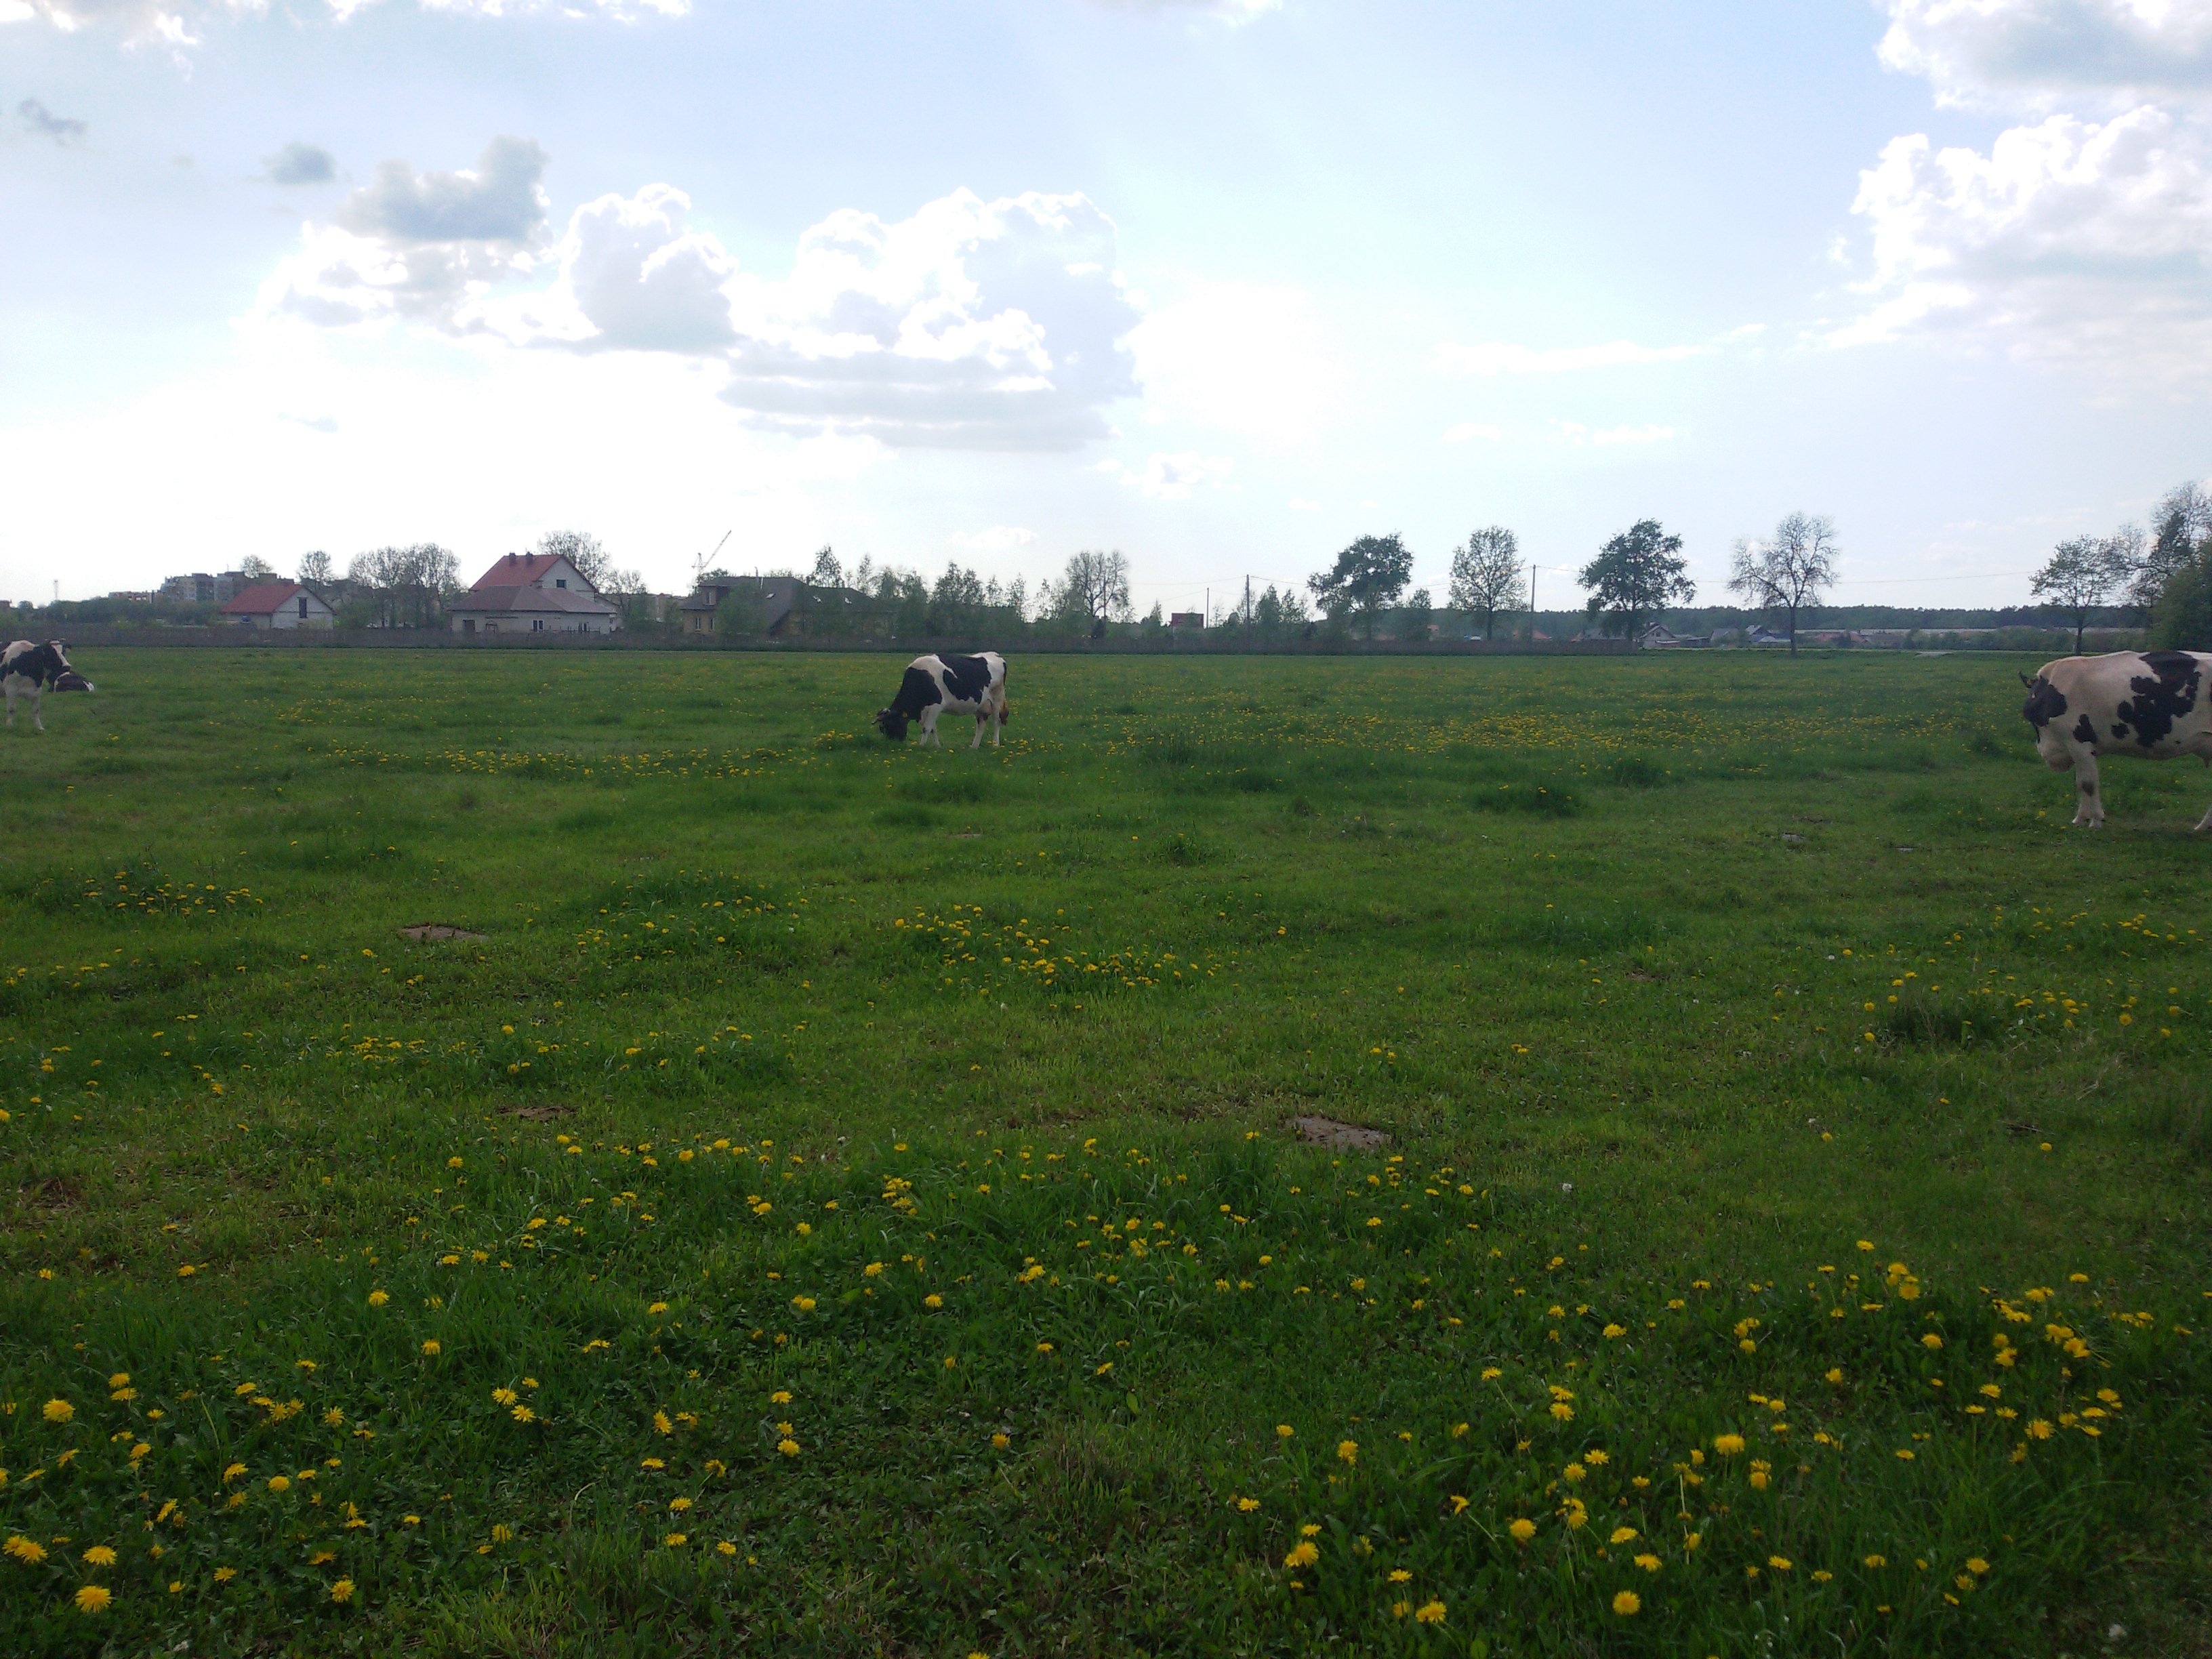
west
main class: Grassland
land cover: Grassland without tree/shrub cover
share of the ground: > 75 %
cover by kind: herbaceous plants 100 %
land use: Agriculture (excluding fallow land and kitchen gardens)
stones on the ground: < 10 %
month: May
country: PL
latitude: 52.9940
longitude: 22.2640
